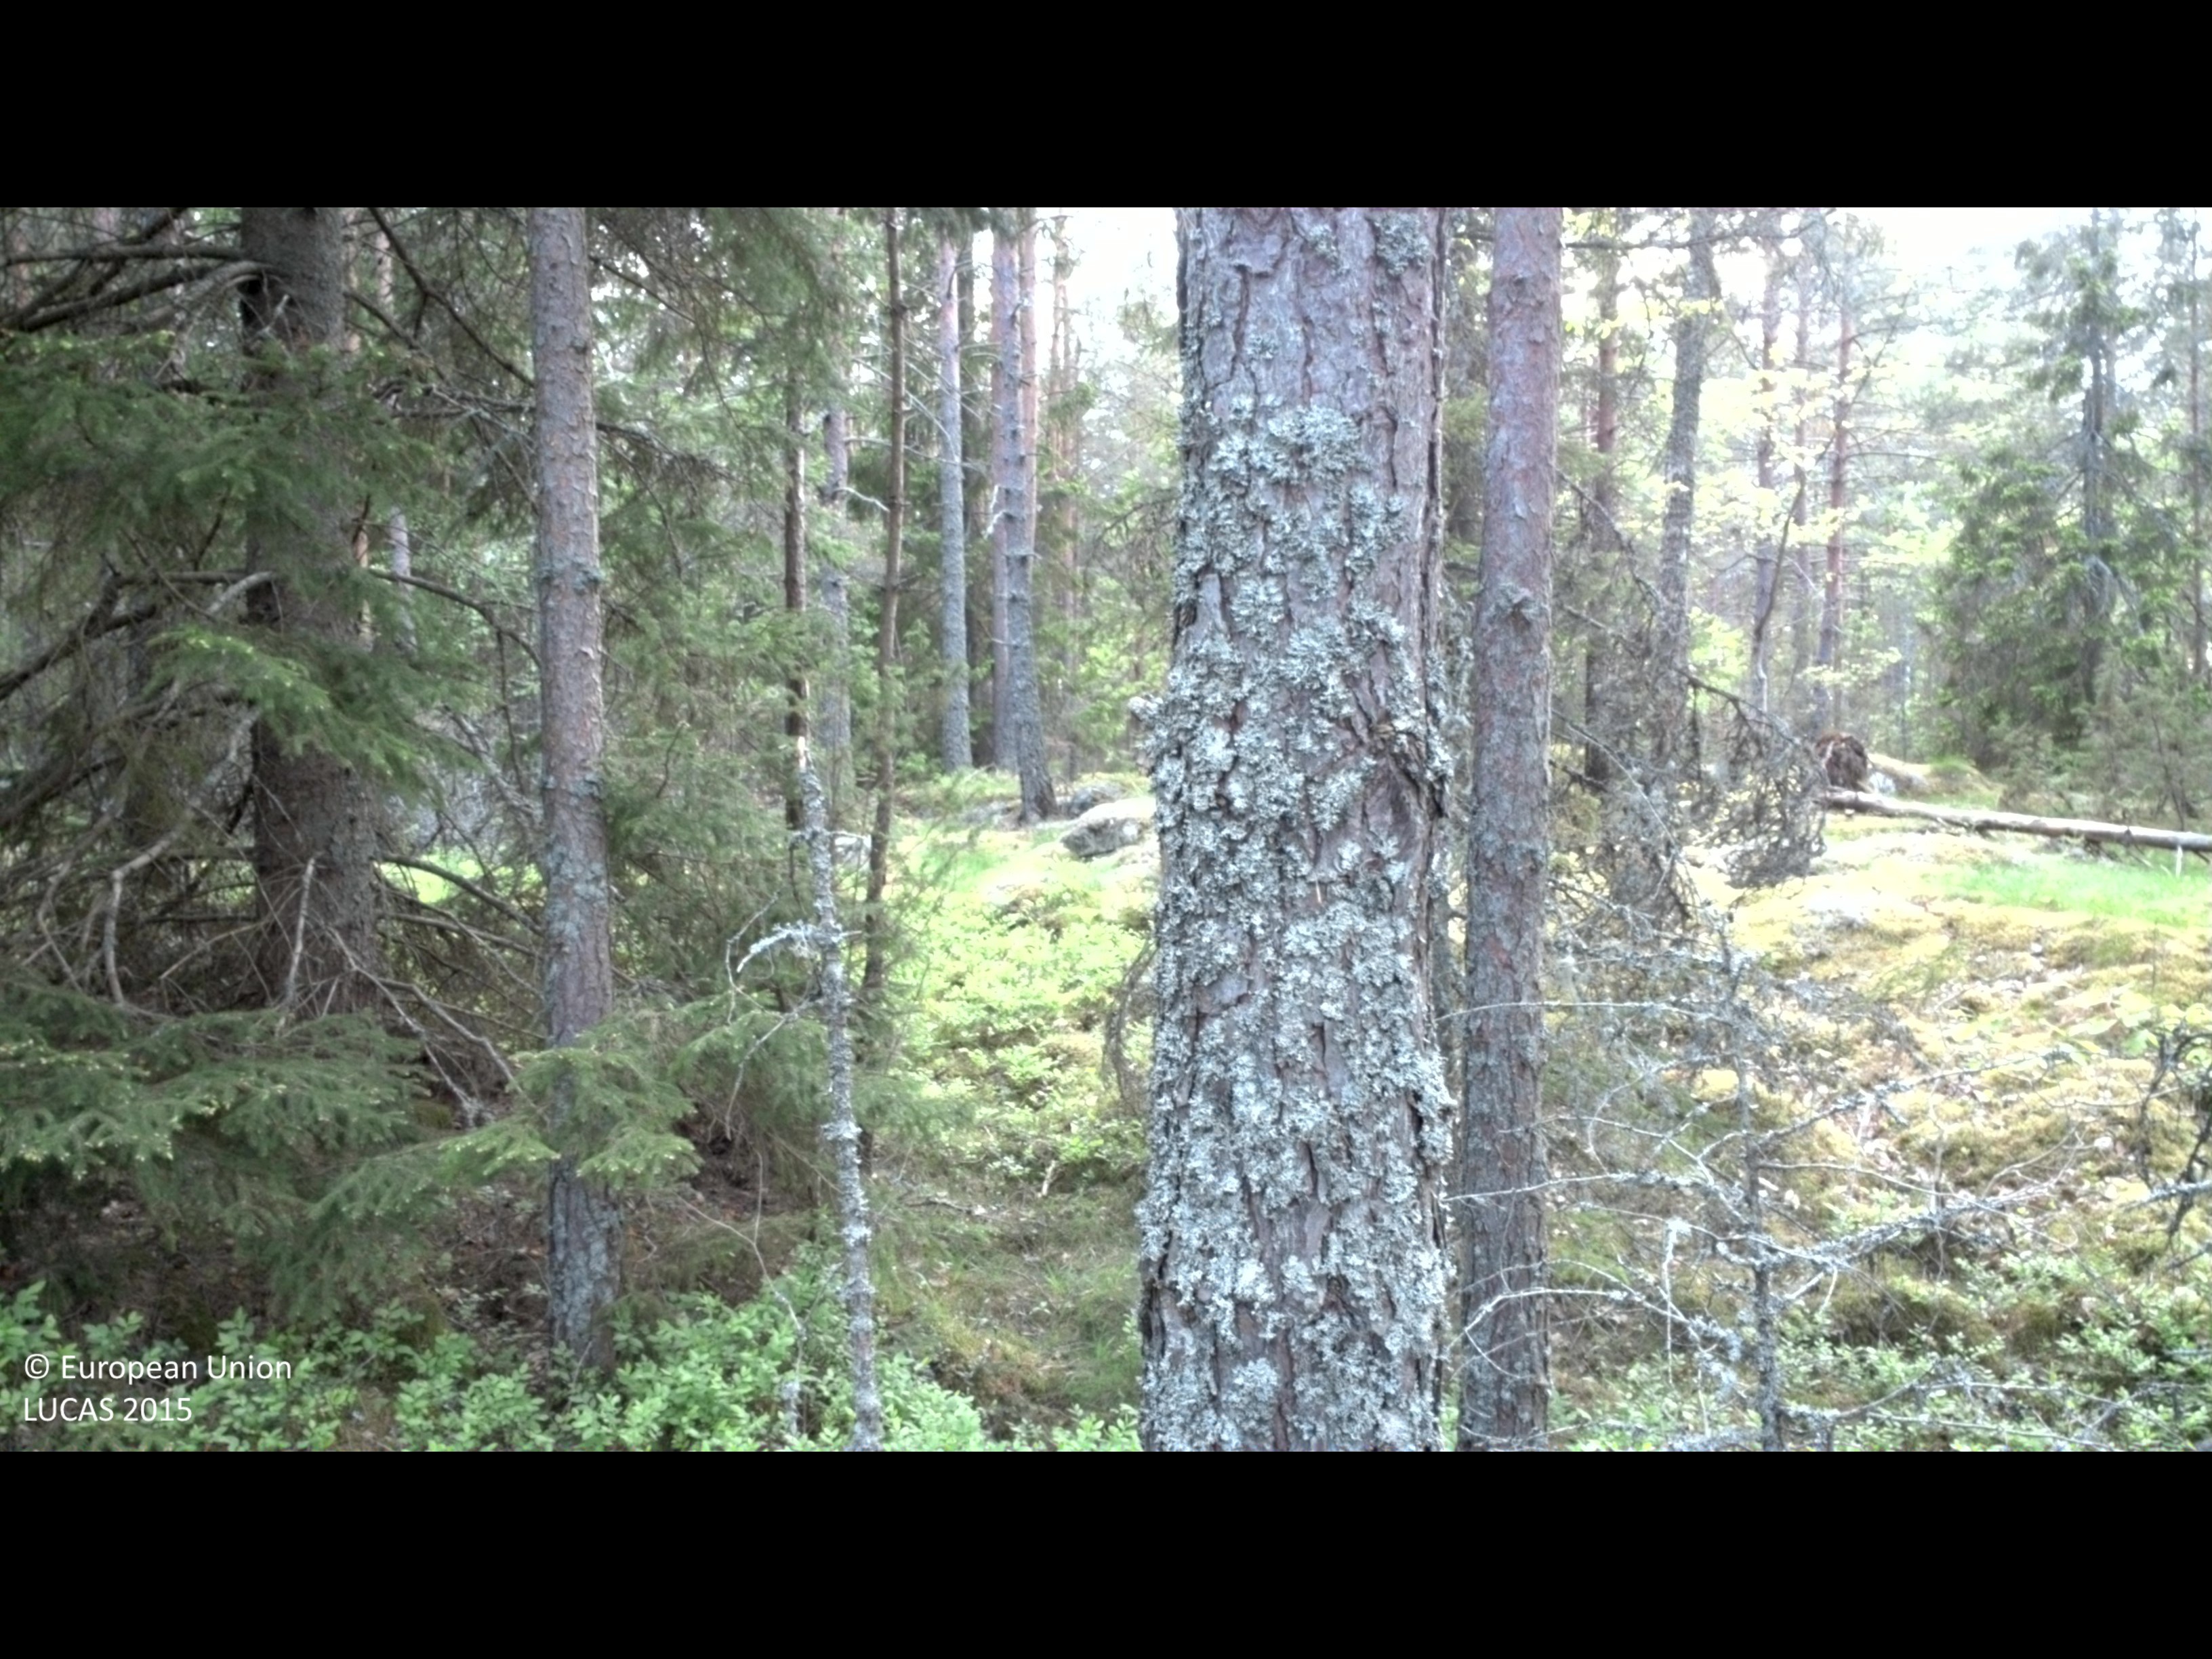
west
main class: Woodland
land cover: Pine dominated coniferous woodland
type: boreal forest
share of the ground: 50 - 75 %
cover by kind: coniferous forest trees 65 %, shrubs 15 %, lichens and mosses 10 %, broadleaved forest trees 5 %, herbaceous plants 5 %
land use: Forestry
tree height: > 5 m
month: May
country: SE
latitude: 57.4494
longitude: 16.4816
